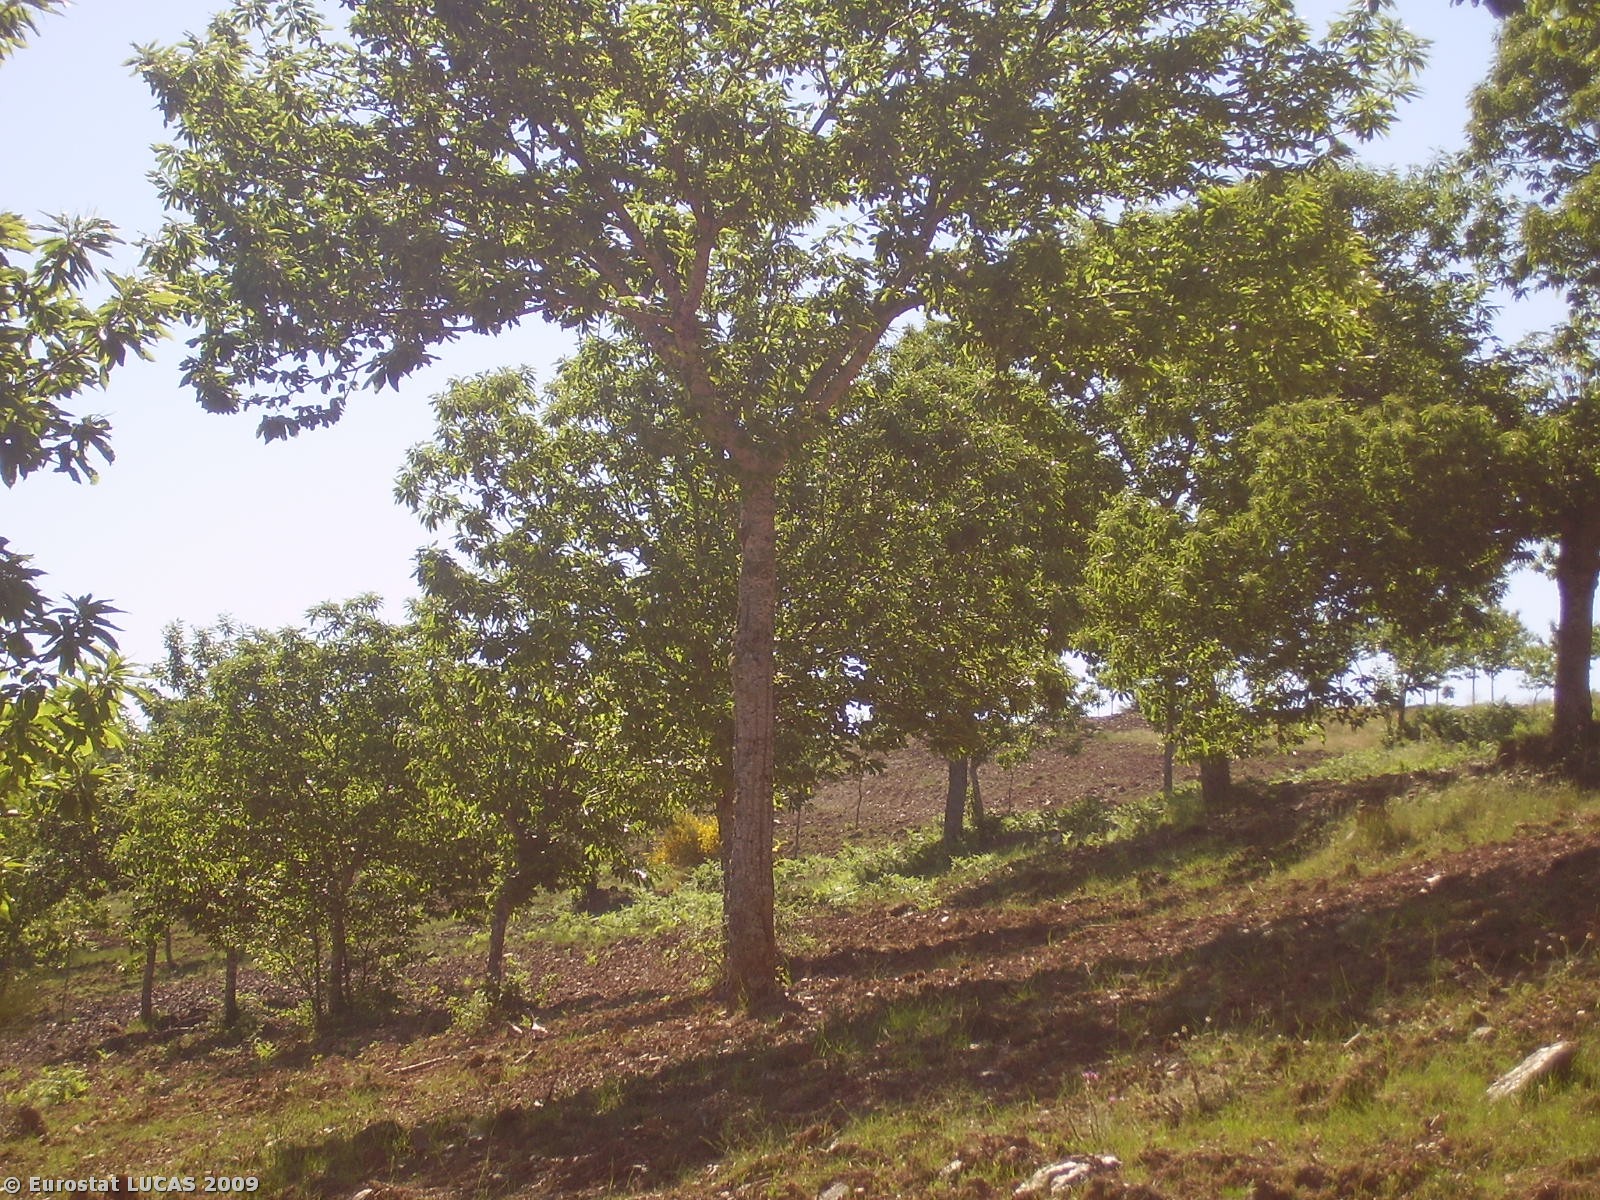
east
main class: Cropland
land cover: Other fruit trees and berries
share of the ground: 10 - 25 %
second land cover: Spontaneously vegetated surfaces
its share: < 10 %
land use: Agriculture (excluding fallow land and kitchen gardens)
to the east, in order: Other fruit trees and berries; Spontaneously vegetated surfaces; Mixed woodland; Bare land; Other fruit trees and berries; Mixed woodland; Grassland without tree/shrub cover
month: June
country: PT
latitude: 41.7528
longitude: -6.9171
